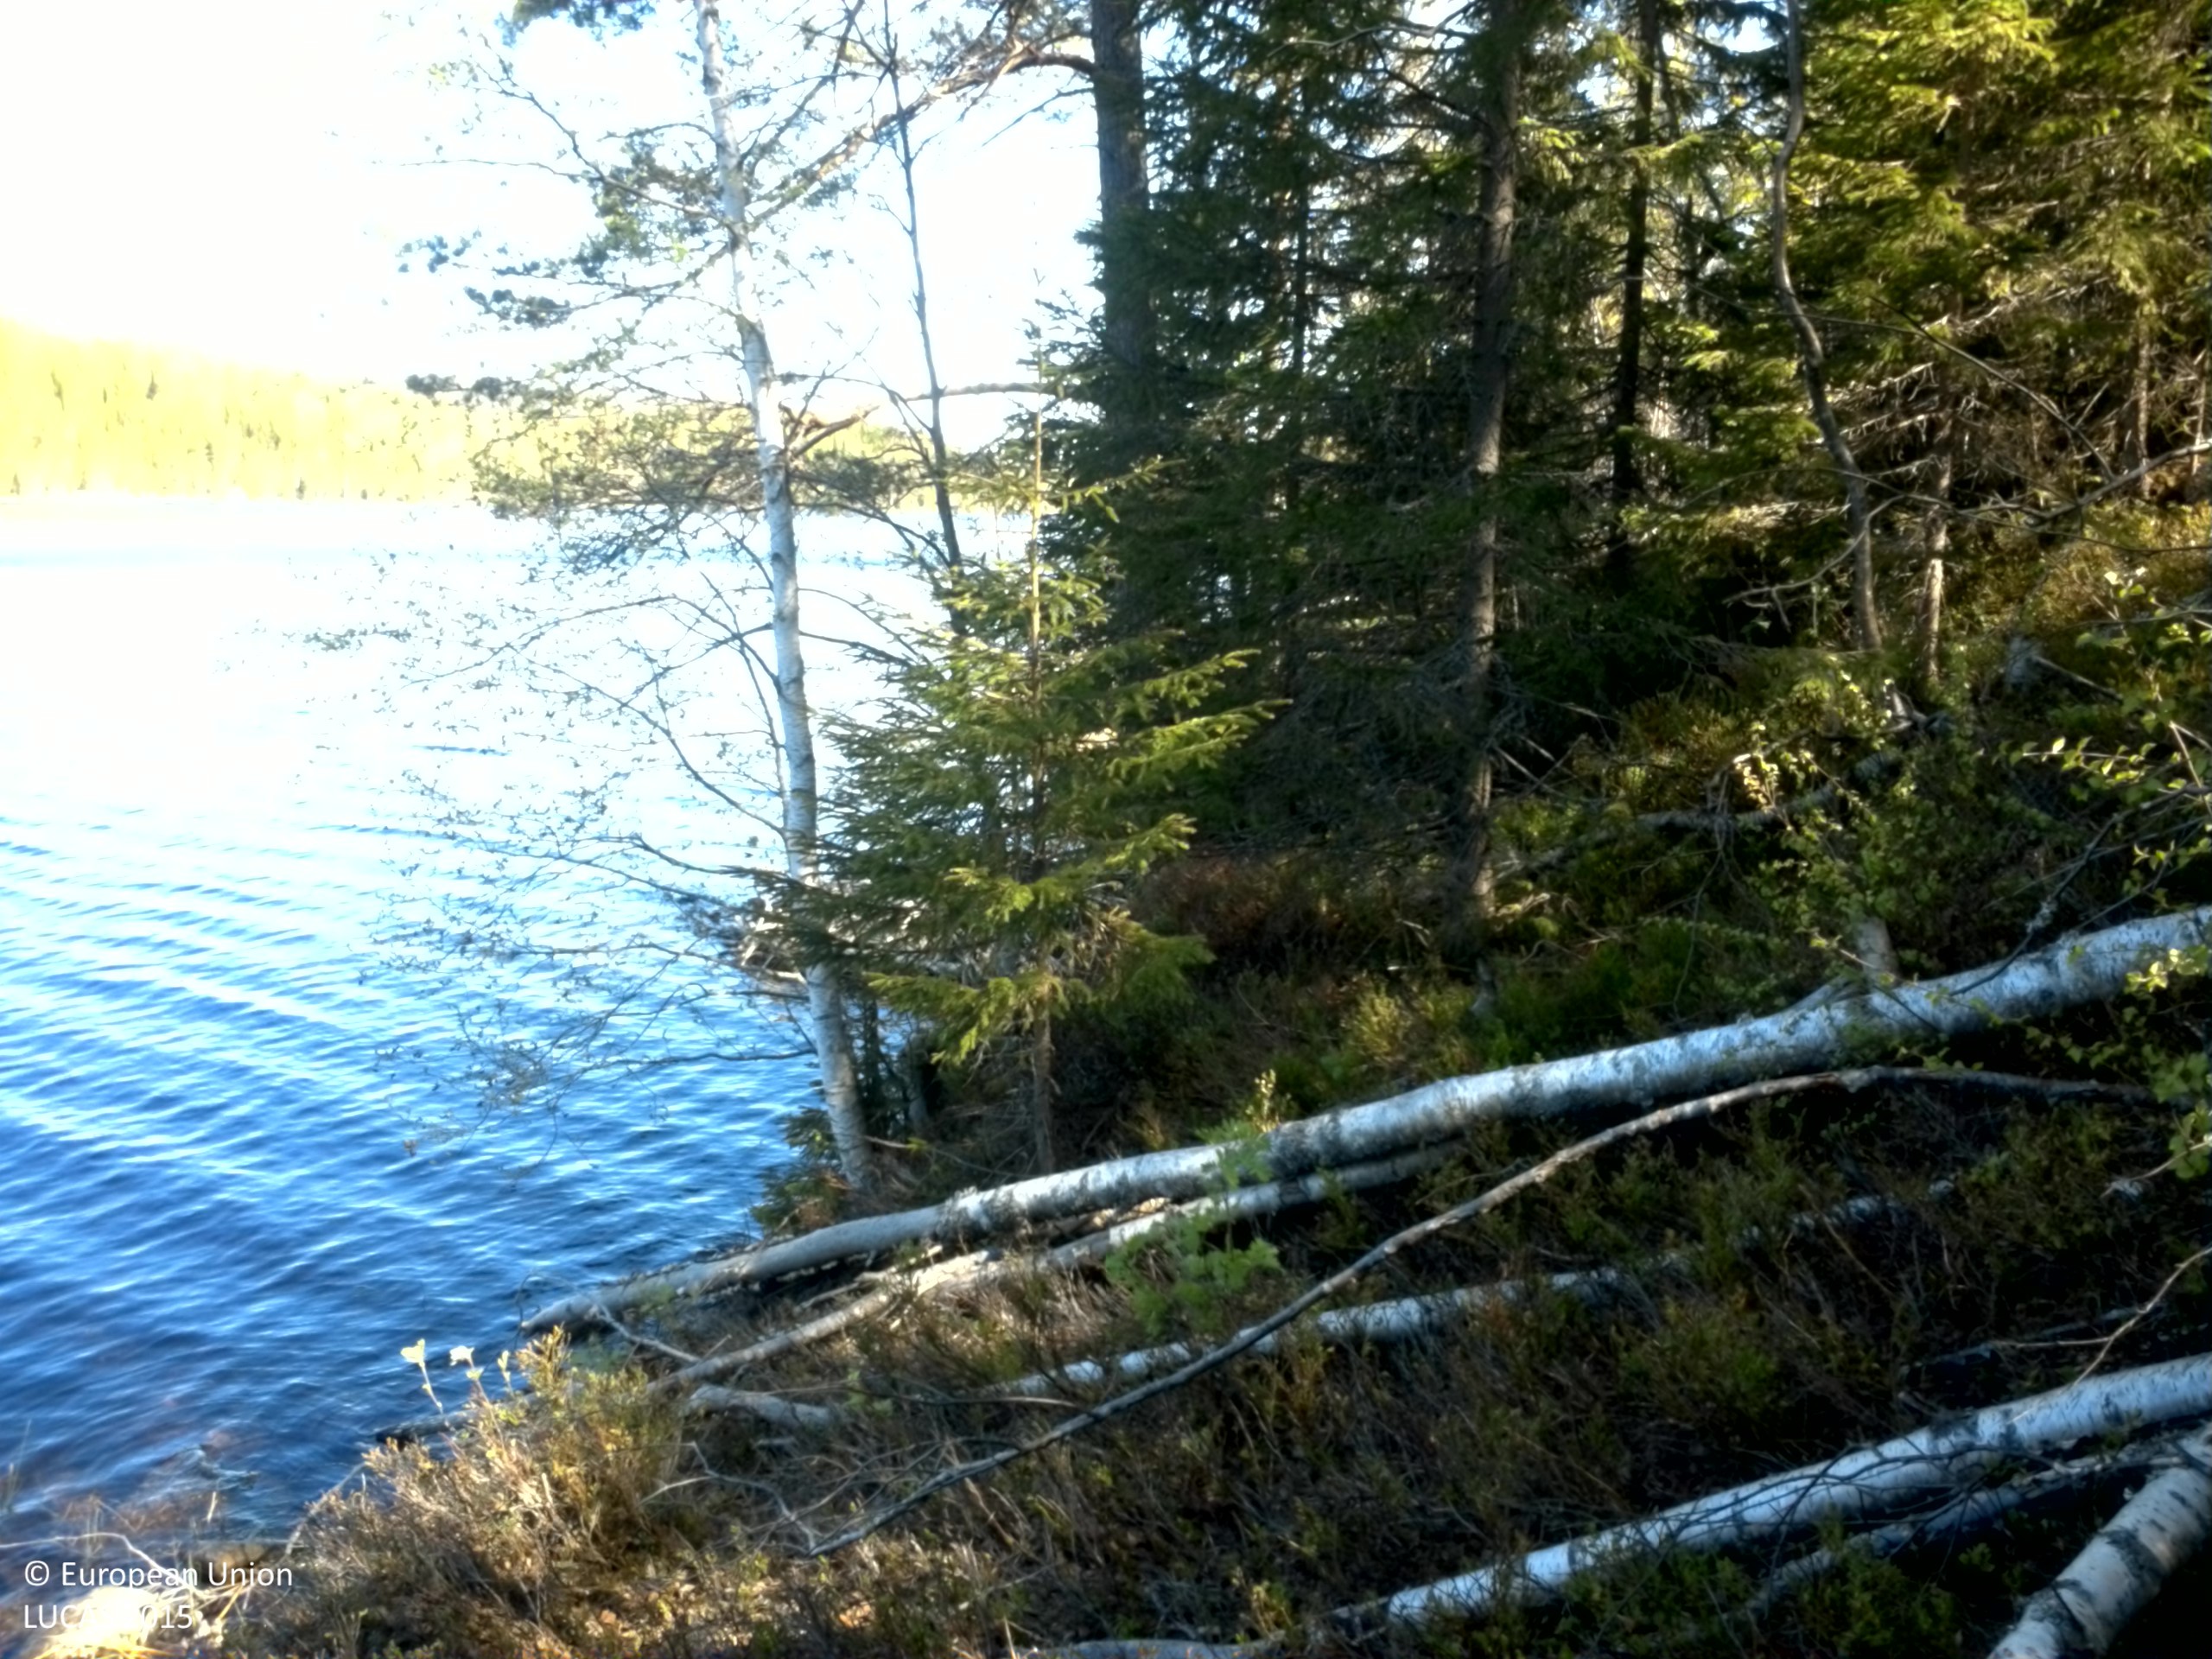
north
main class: Woodland
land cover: Pine dominated mixed woodland
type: boreal forest
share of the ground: > 75 %
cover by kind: coniferous forest trees 60 %, broadleaved forest trees 25 %, shrubs 15 %
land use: Residential
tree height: > 5 m
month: May
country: SE
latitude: 63.0352
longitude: 17.9837
